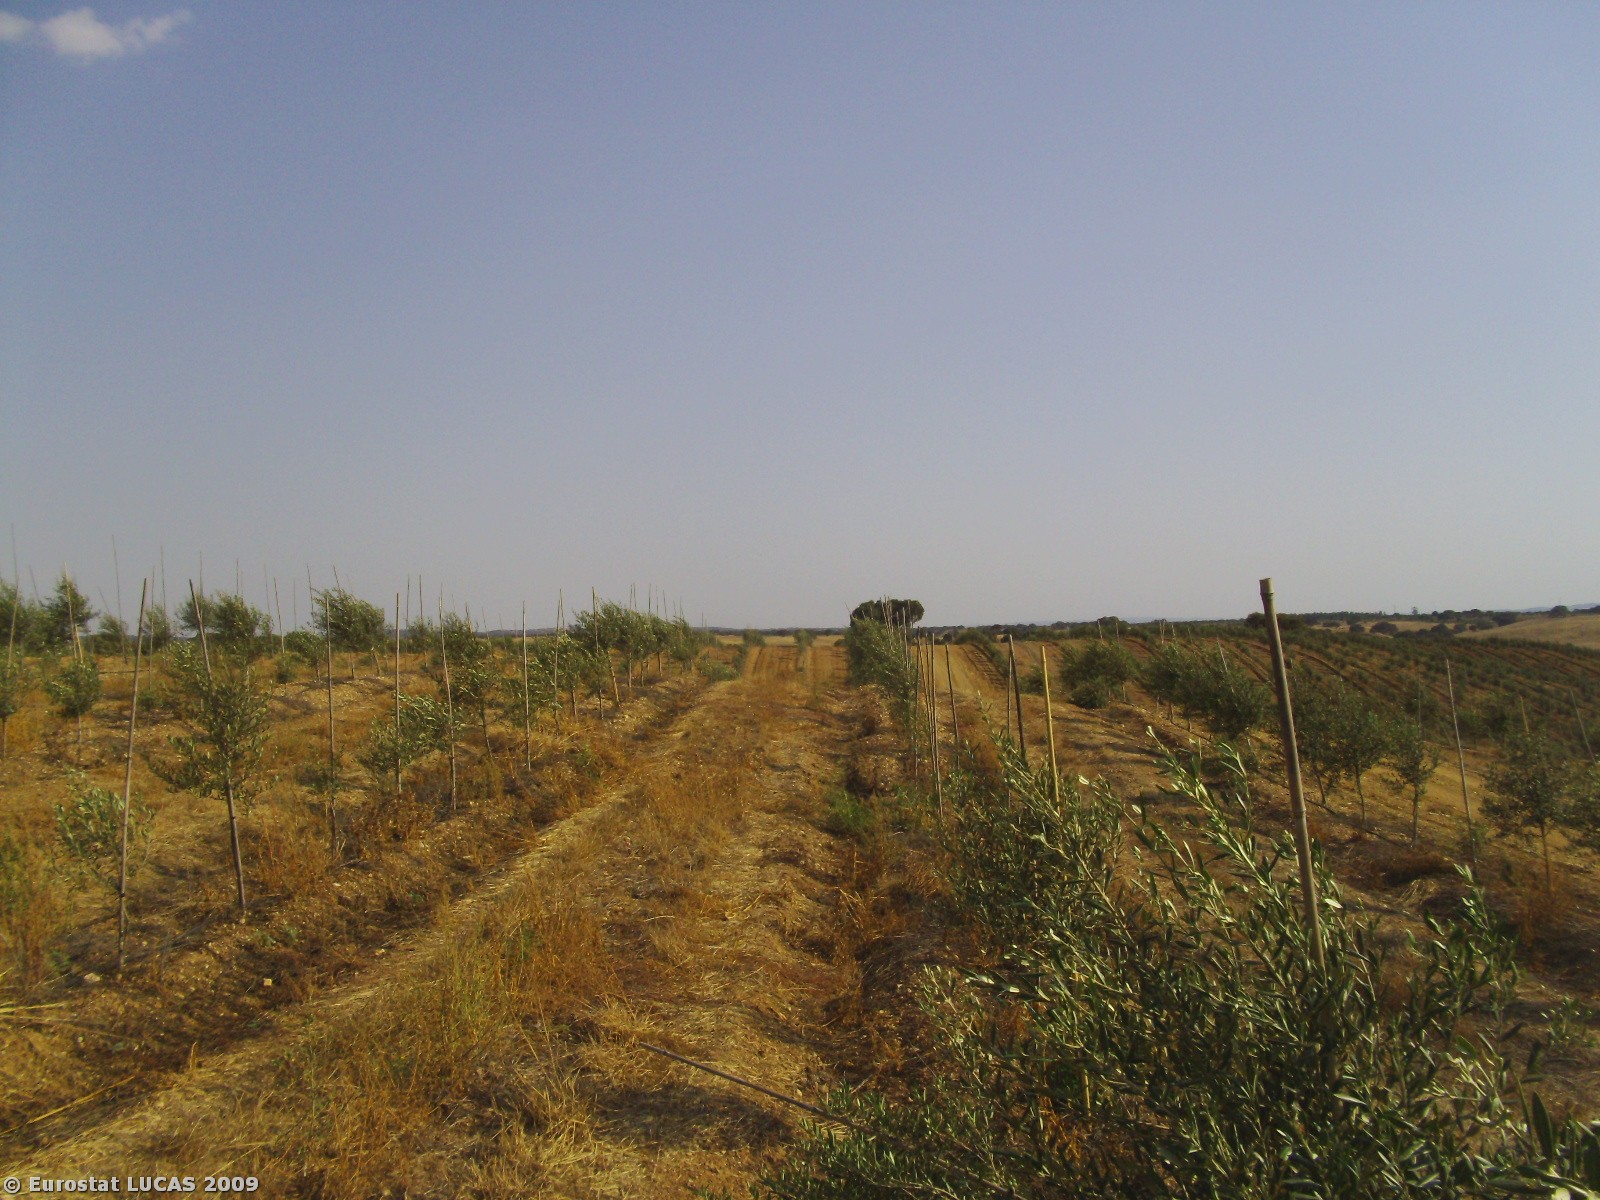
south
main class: Cropland
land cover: Olive groves
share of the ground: 50 - 75 %
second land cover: Spontaneously vegetated surfaces
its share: > 75 %
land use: Agriculture (excluding fallow land and kitchen gardens)
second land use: Fallow land
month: August
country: PT
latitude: 37.8762
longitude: -8.3286
